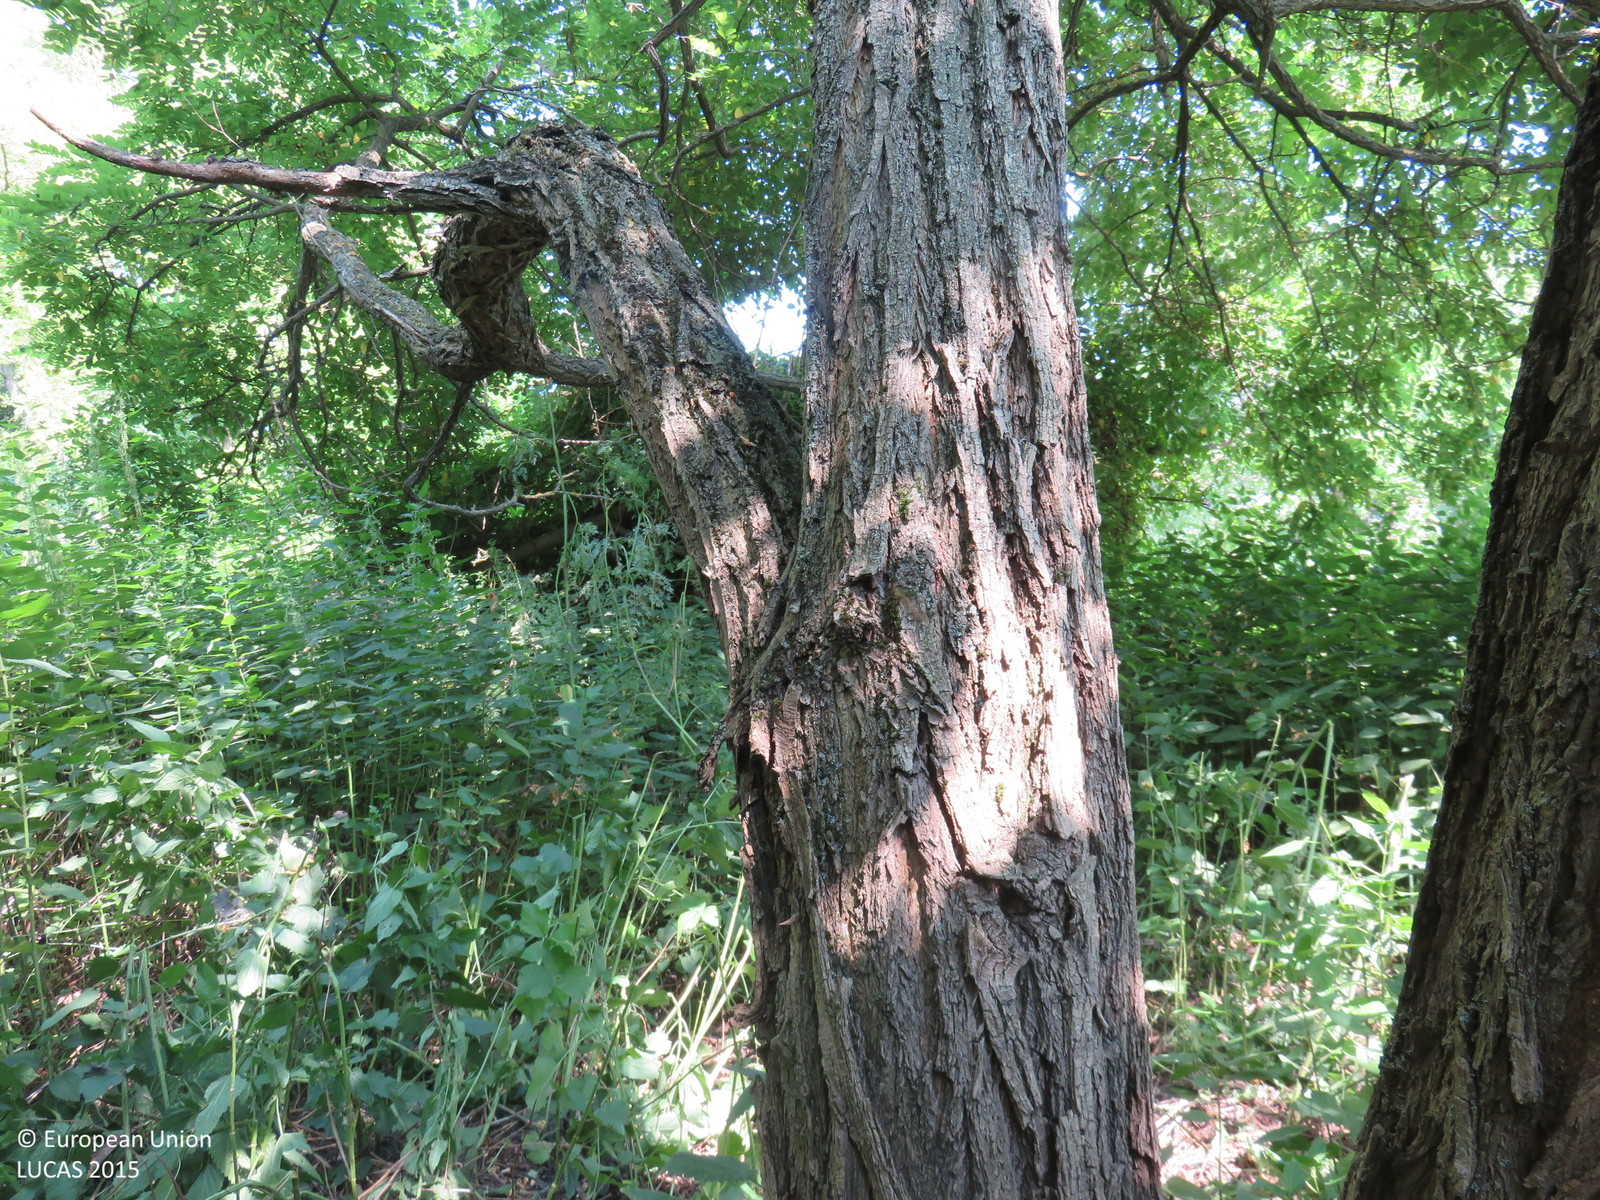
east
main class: Woodland
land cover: Broadleaved woodland
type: mesophytic deciduous forest
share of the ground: > 75 %
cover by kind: broadleaved forest trees 85 %, herbaceous plants 10 %, shrubs 5 %
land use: Forestry
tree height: < 5 m
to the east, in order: Broadleaved woodland; Paved roads, cycling and walking lanes; Broadleaved woodland; Ditches and canals; Broadleaved woodland; Rivers and streams; Broadleaved woodland
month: July
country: BG
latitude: 43.5906
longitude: 24.9467
